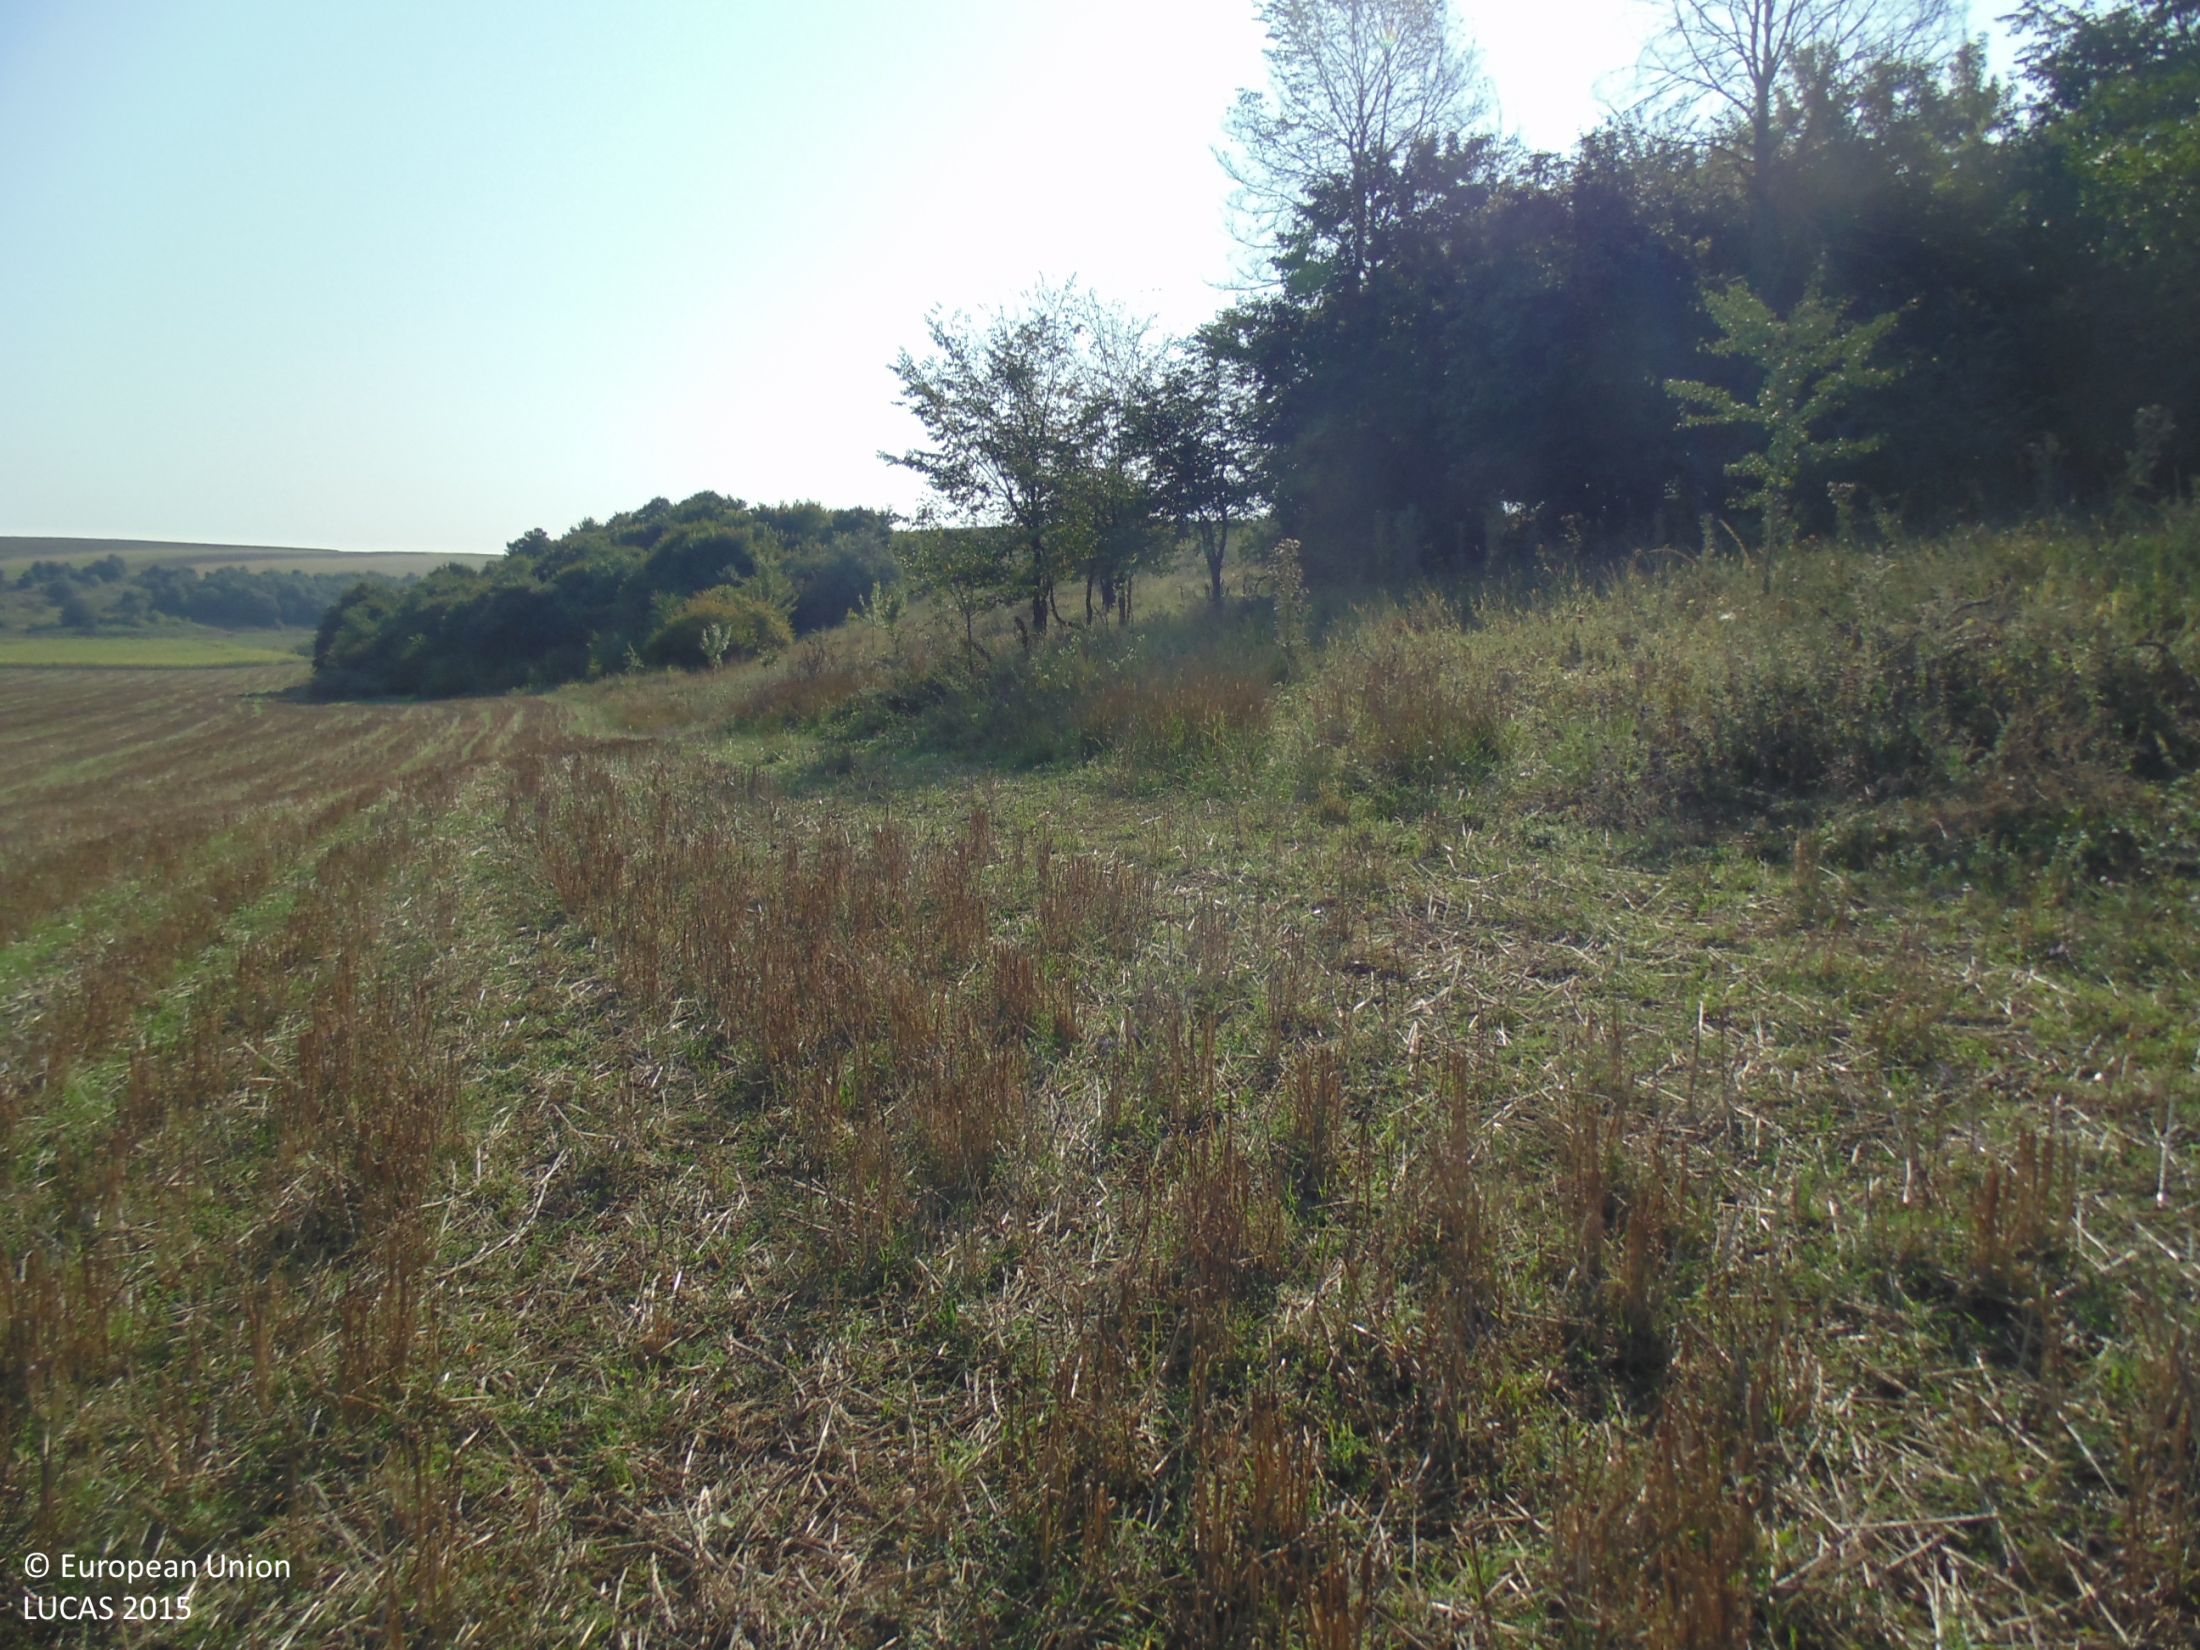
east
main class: Cropland
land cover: Common wheat
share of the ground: 25 - 50 %
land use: Agriculture (excluding fallow land and kitchen gardens)
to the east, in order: Common wheat; Grassland with sparse tree/shrub cover; Broadleaved woodland; Grassland with sparse tree/shrub cover; Common wheat
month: September
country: BG
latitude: 43.7549
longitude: 27.0500
